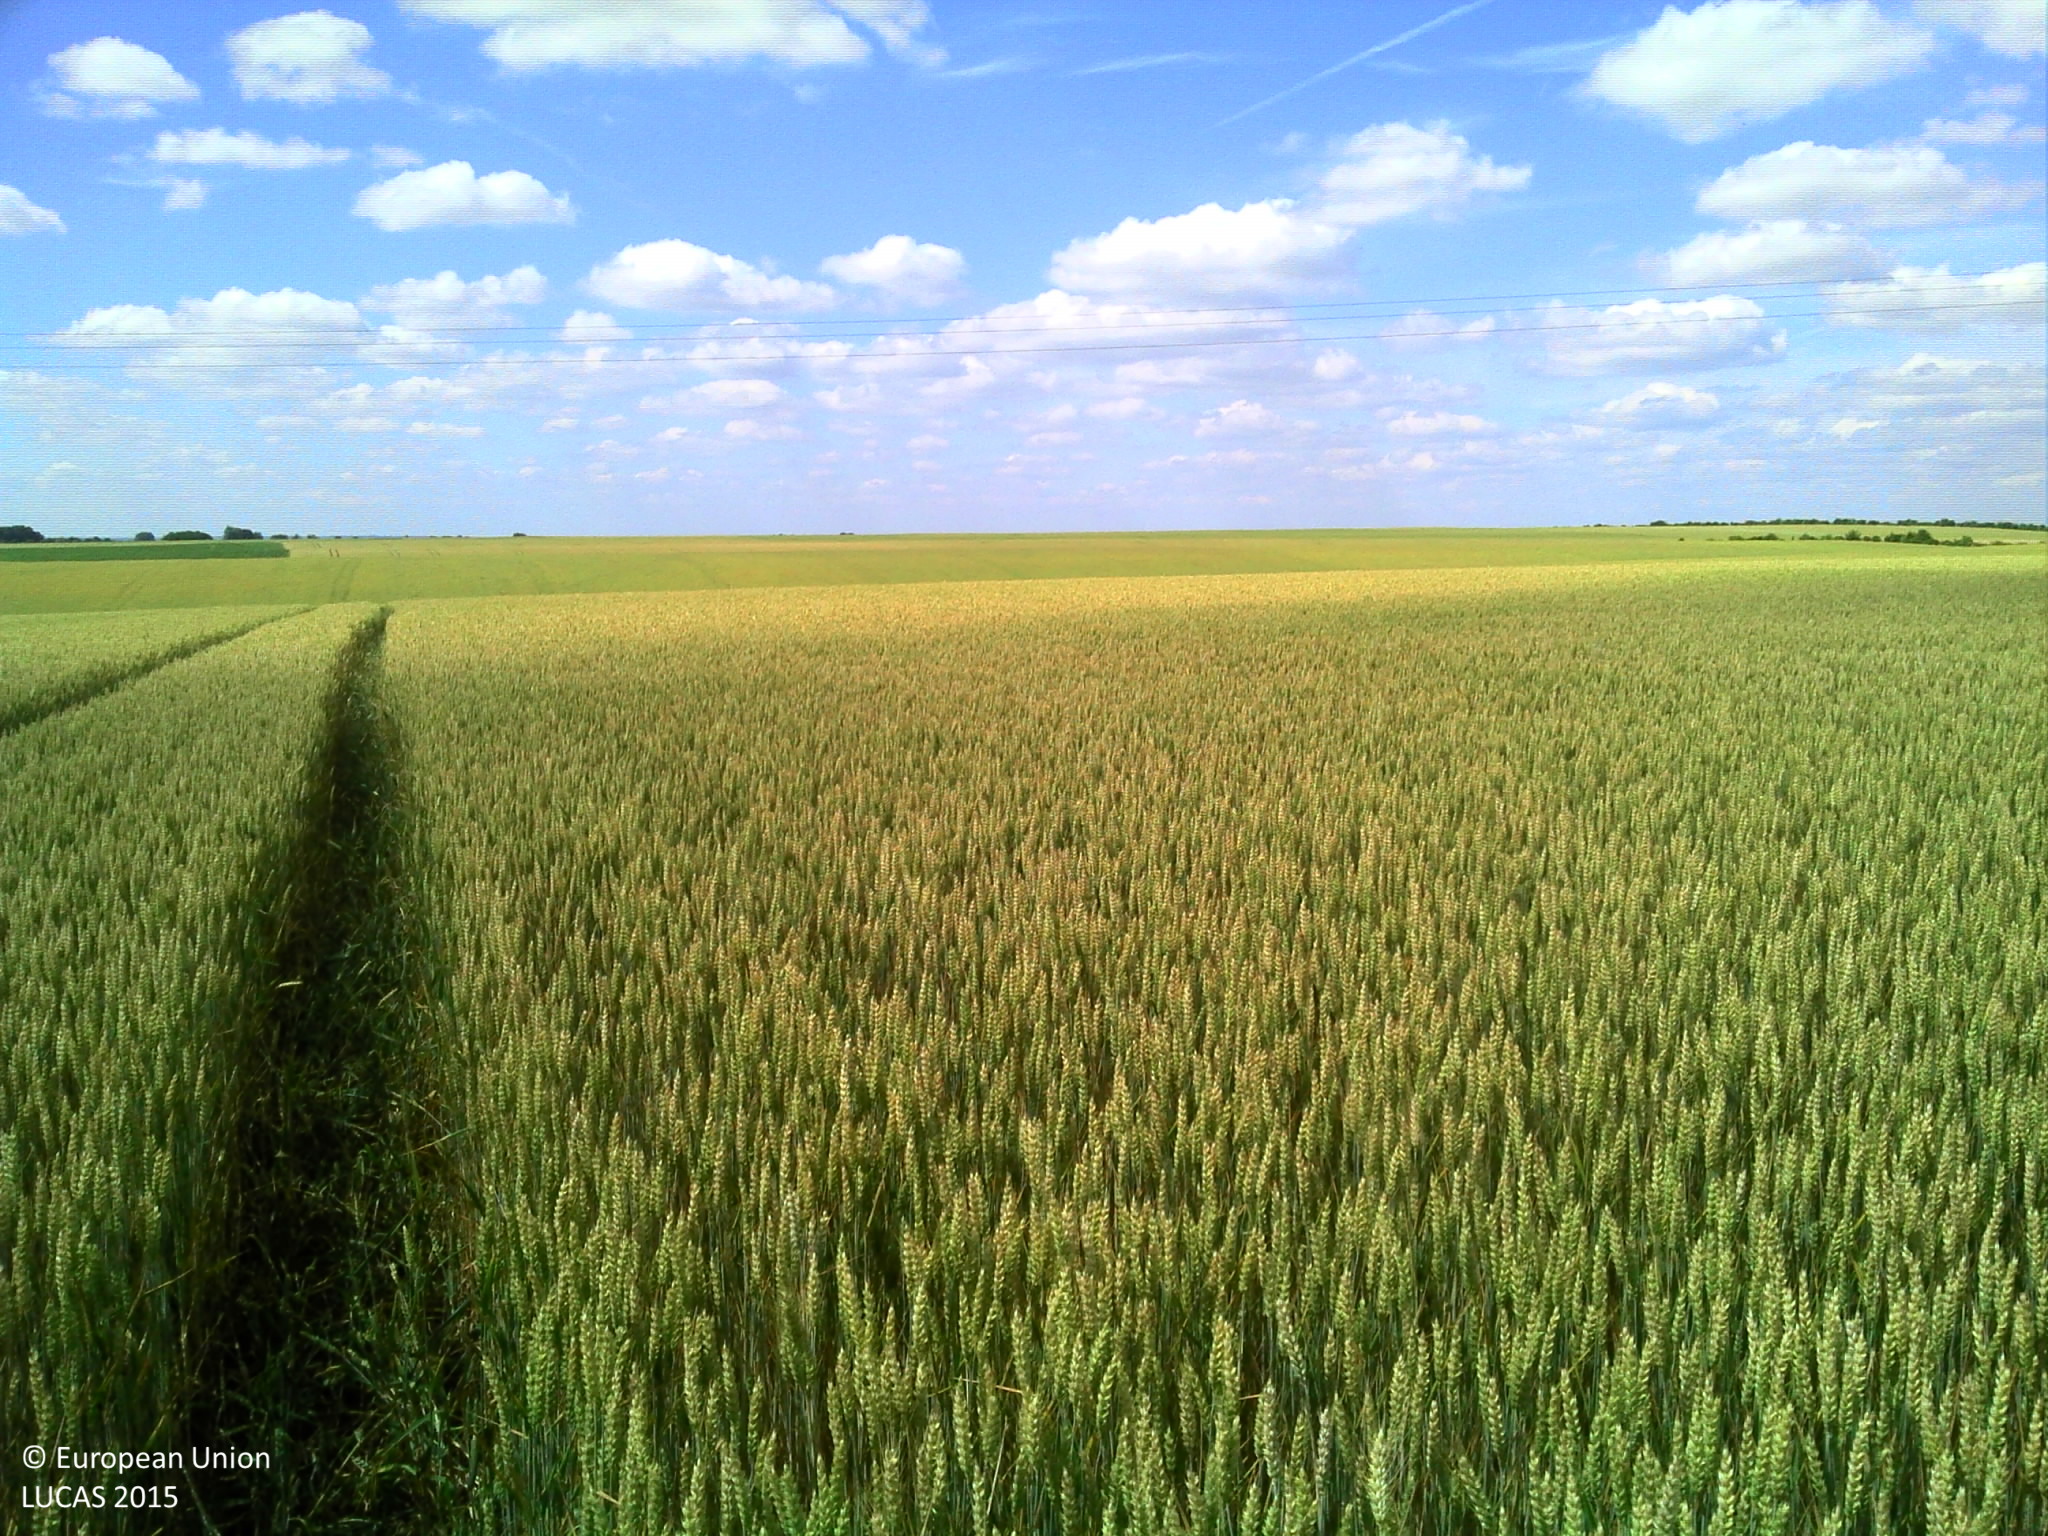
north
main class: Cropland
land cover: Common wheat
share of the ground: > 75 %
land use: Agriculture (excluding fallow land and kitchen gardens)
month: June
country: FR
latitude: 49.0484
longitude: 5.9085
